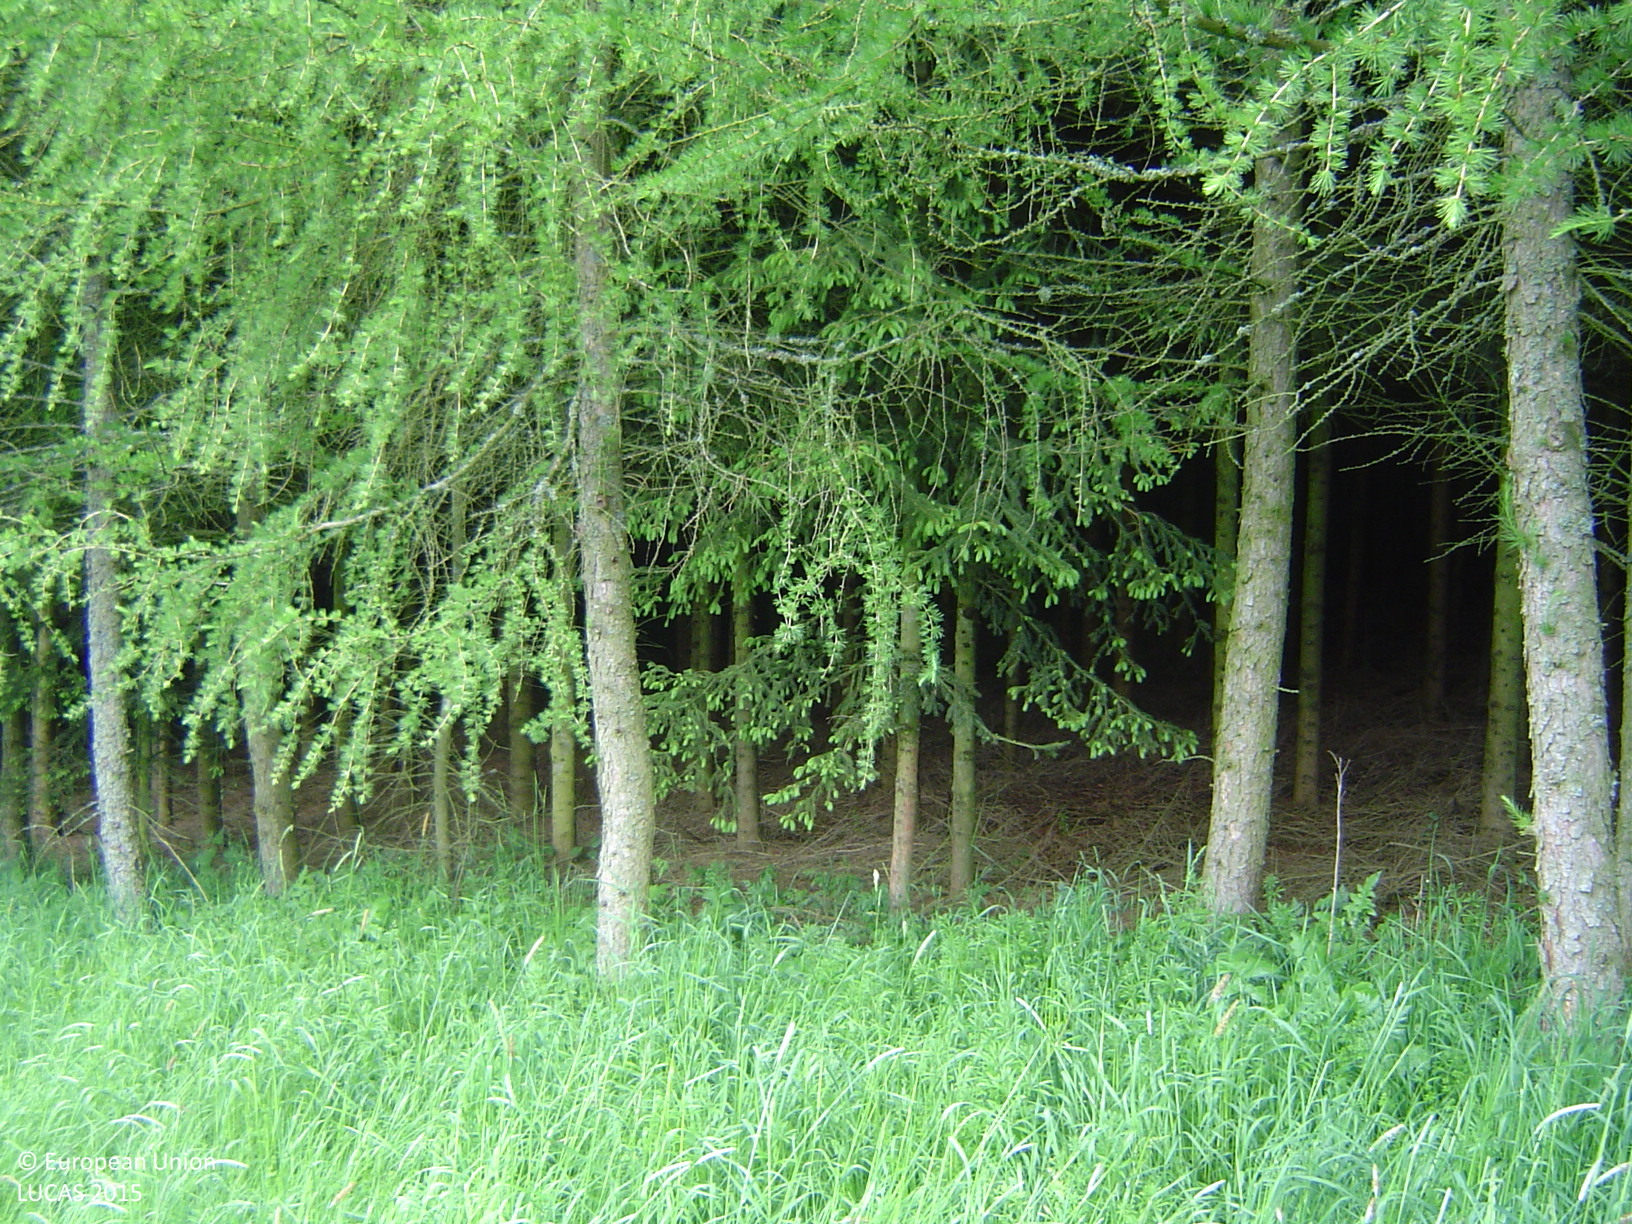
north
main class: Grassland
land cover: Grassland without tree/shrub cover
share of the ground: > 75 %
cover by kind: herbaceous plants 100 %
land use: Agriculture (excluding fallow land and kitchen gardens)
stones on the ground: 10 - 25 %
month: May
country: CZ
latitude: 49.5802
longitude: 16.2439
